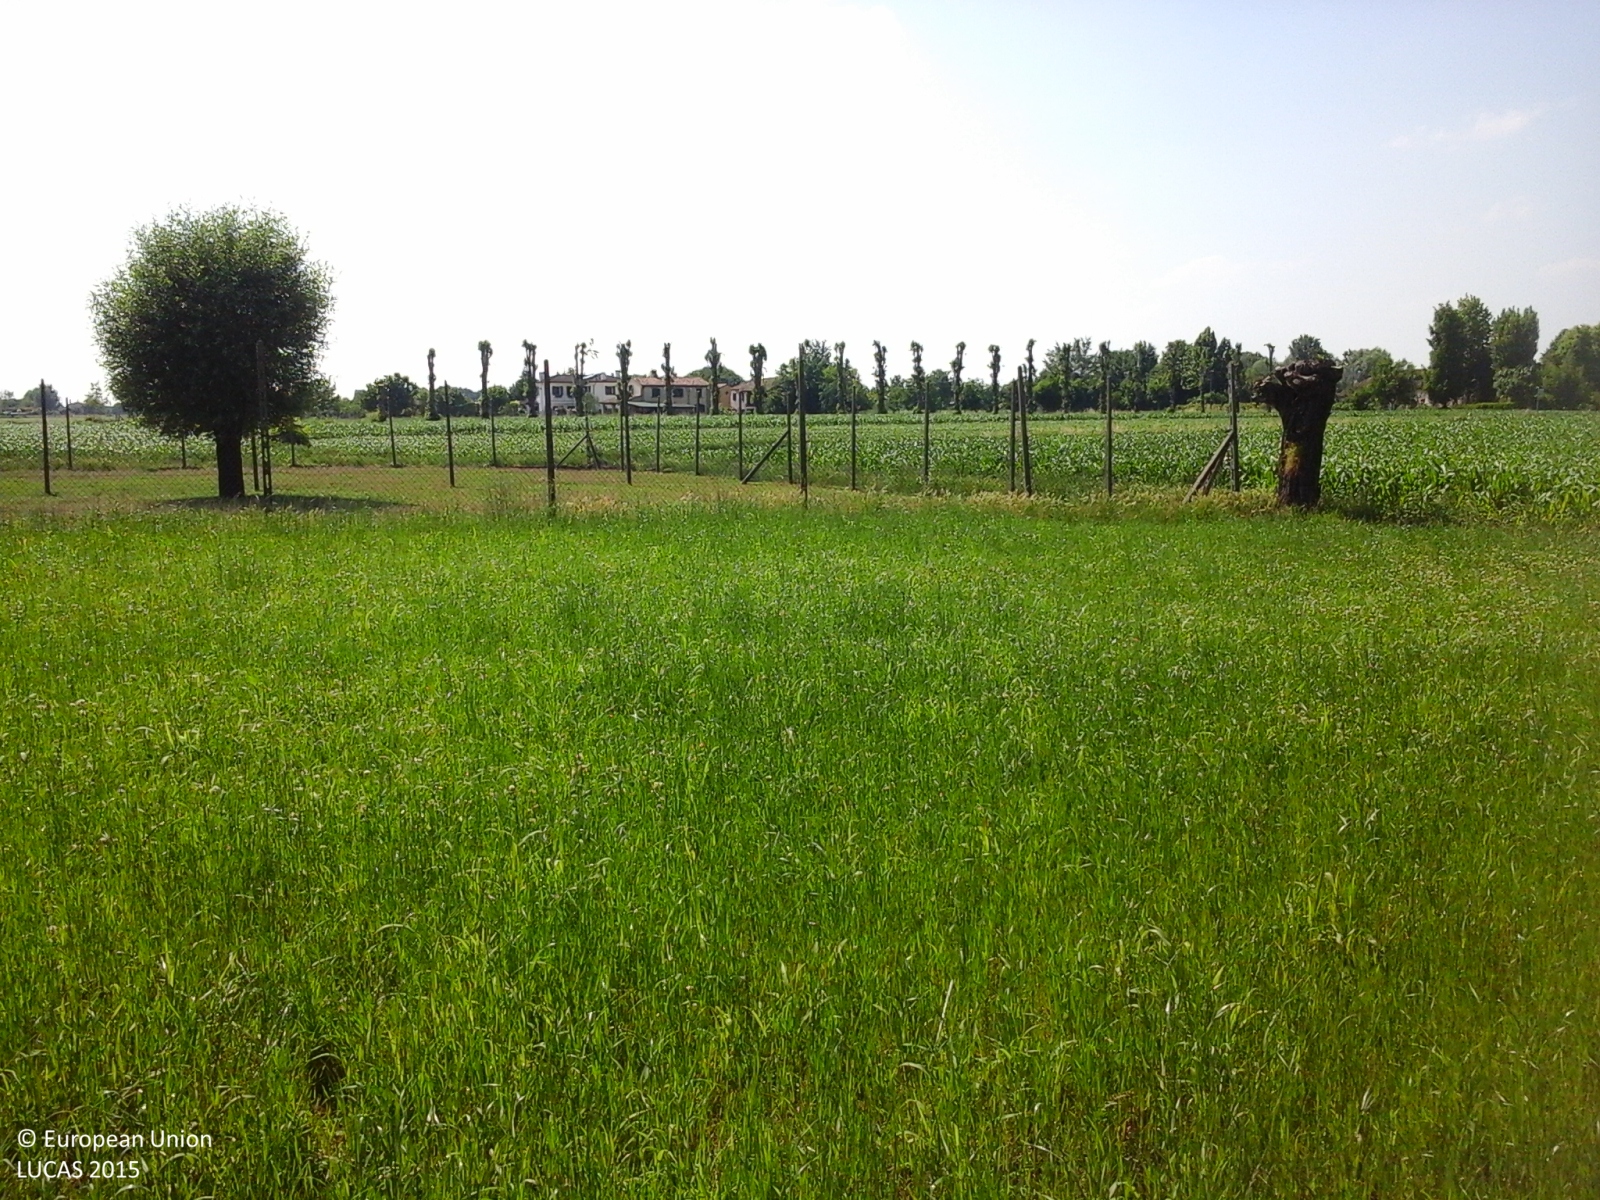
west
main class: Grassland
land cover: Spontaneously vegetated surfaces
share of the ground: > 75 %
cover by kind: herbaceous plants 100 %
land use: Agriculture (excluding fallow land and kitchen gardens)
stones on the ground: < 10 %
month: May
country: IT
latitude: 45.2044
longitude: 11.5631
